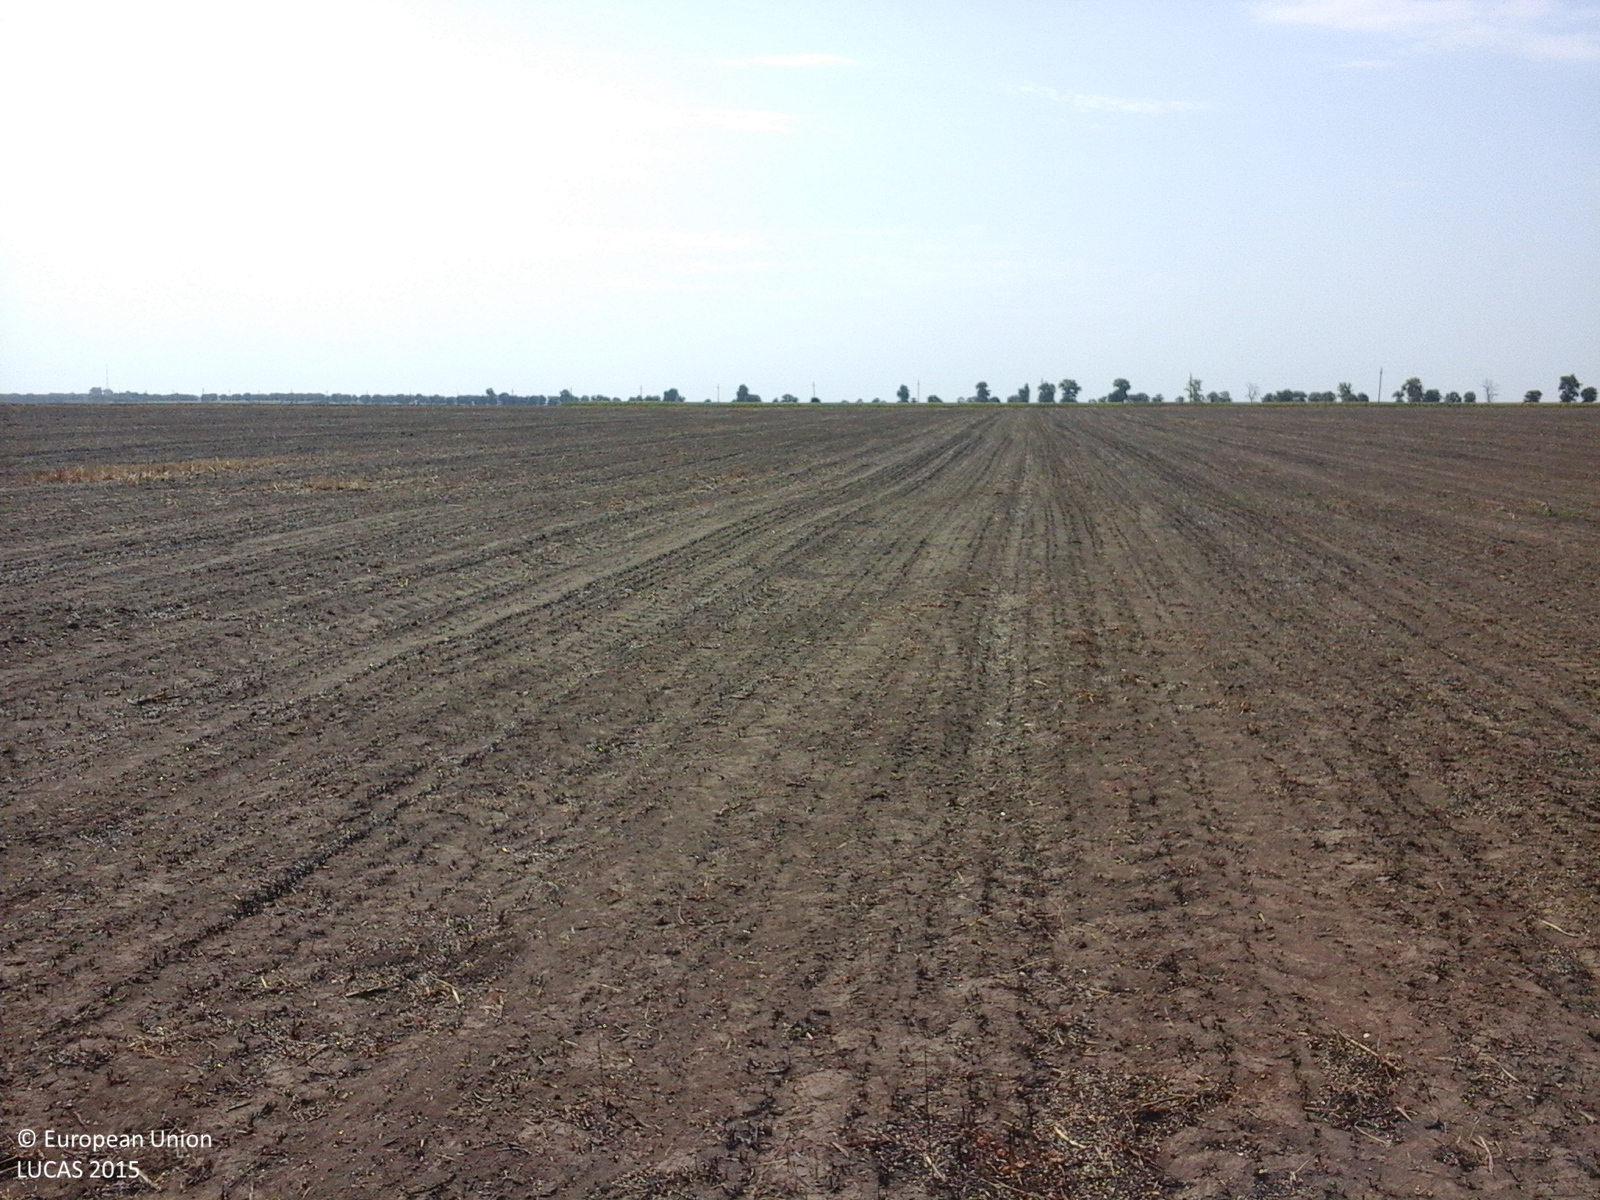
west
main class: Cropland
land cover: Common wheat
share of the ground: < 10 %
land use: Agriculture (excluding fallow land and kitchen gardens)
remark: Burnt area
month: August
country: RO
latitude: 43.7966
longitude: 28.1889
